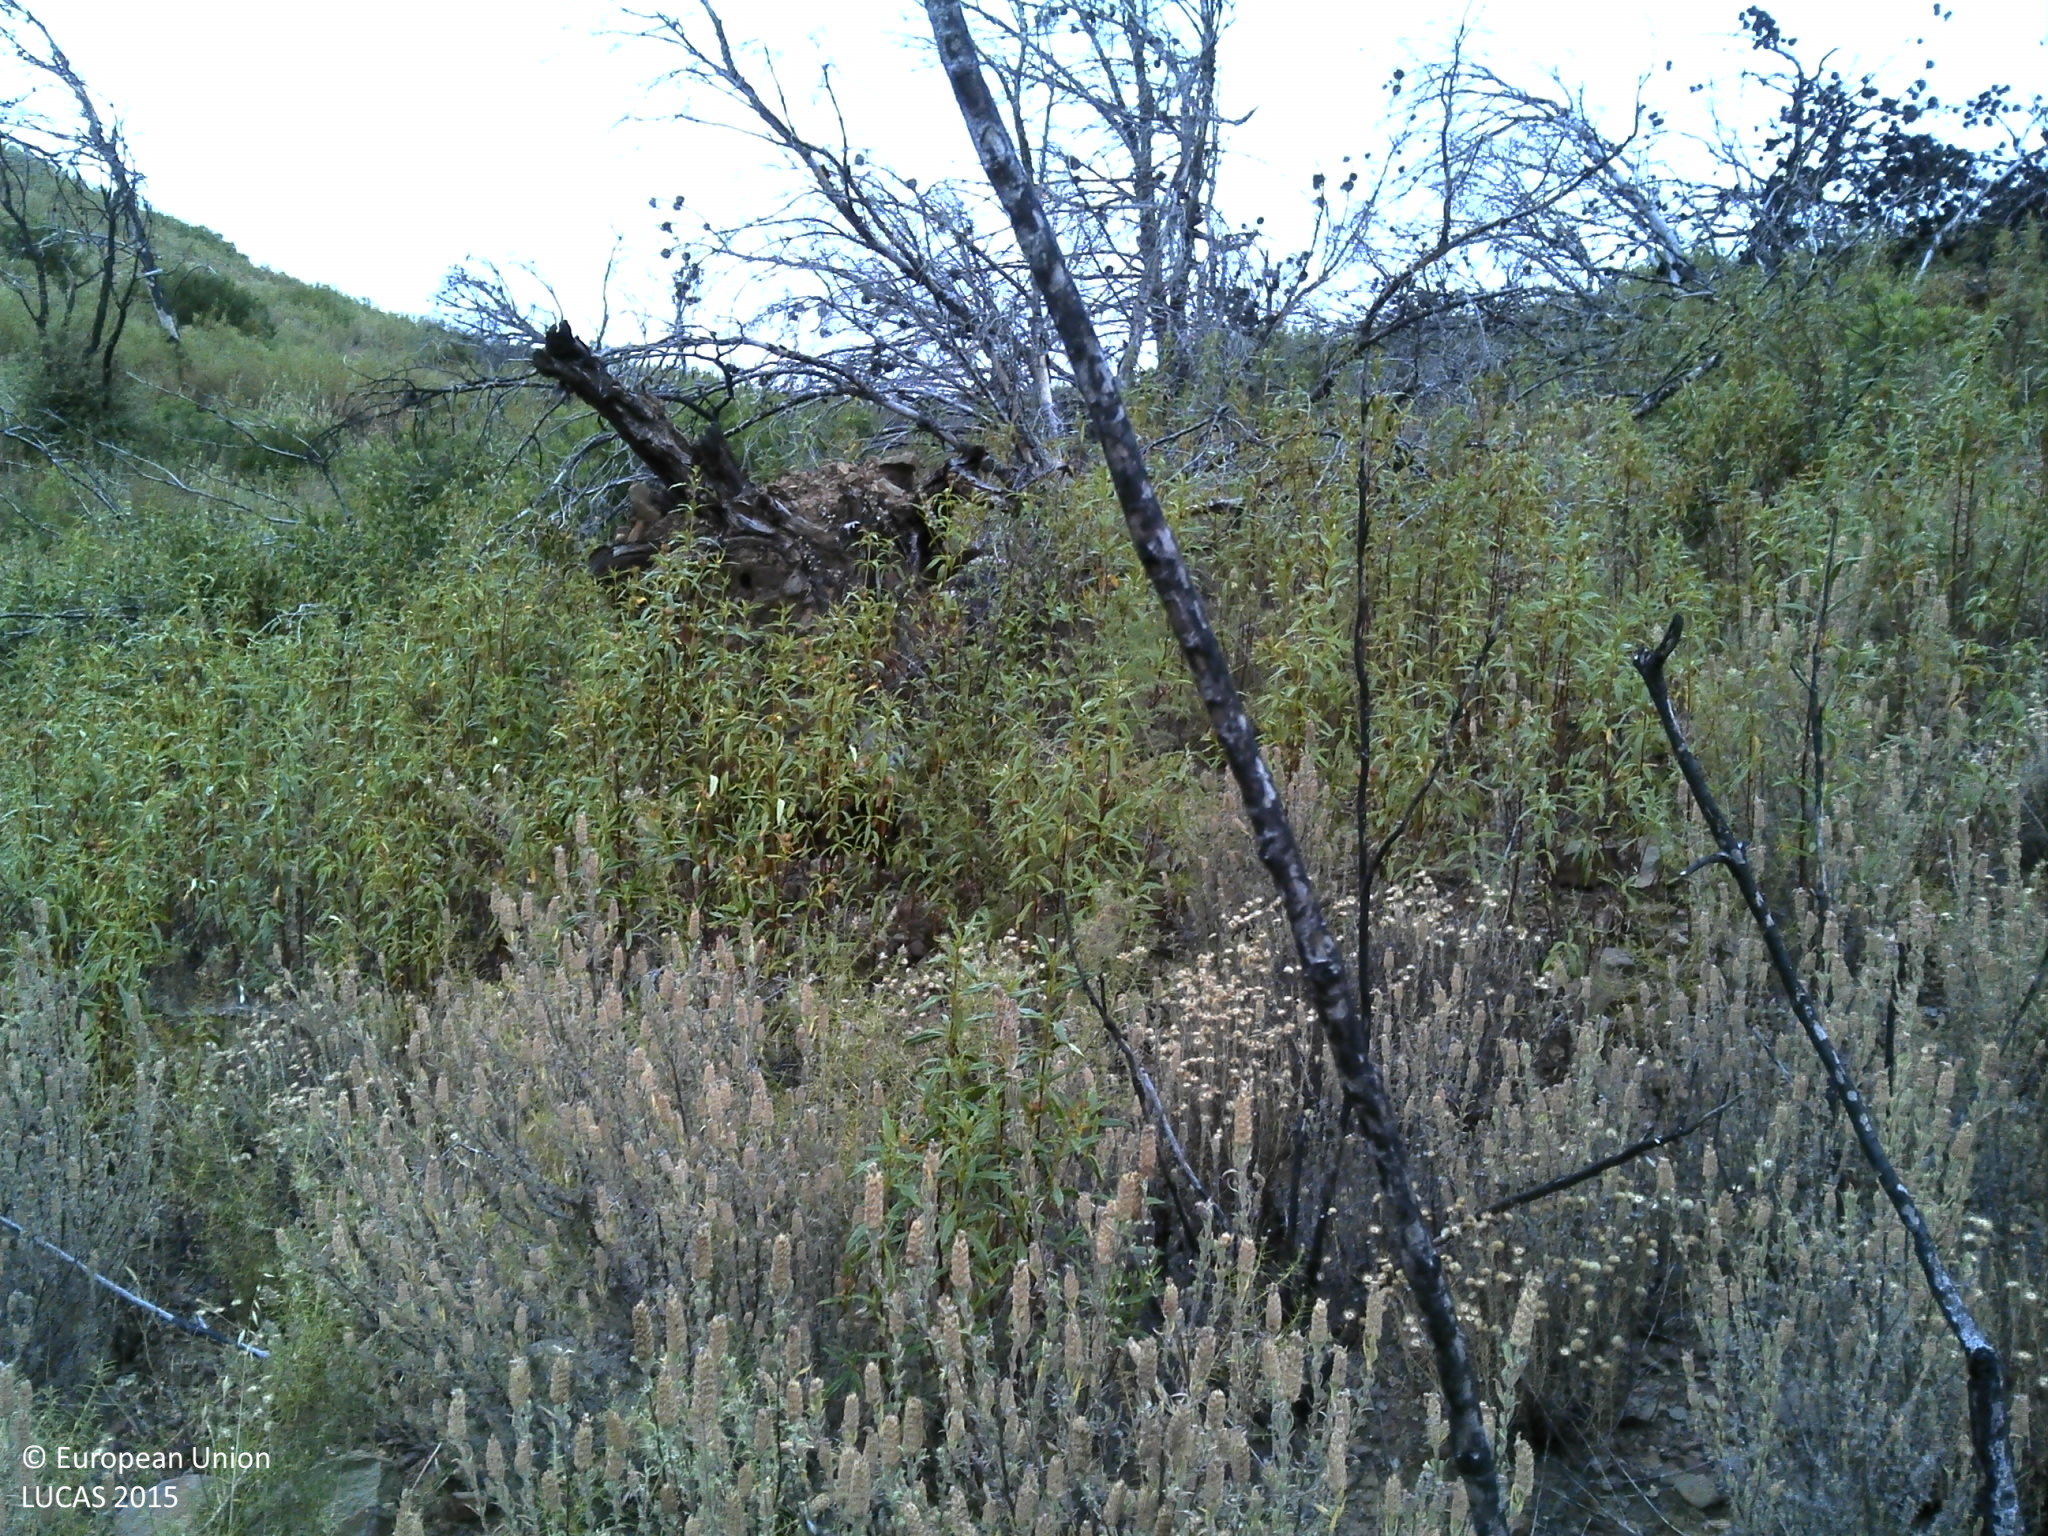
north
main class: Shrubland
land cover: Shrubland without tree cover
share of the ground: 50 - 75 %
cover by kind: shrubs 100 %
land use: Abandoned areas
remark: Burnt area
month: June
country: PT
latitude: 37.1608
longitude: -7.7202
